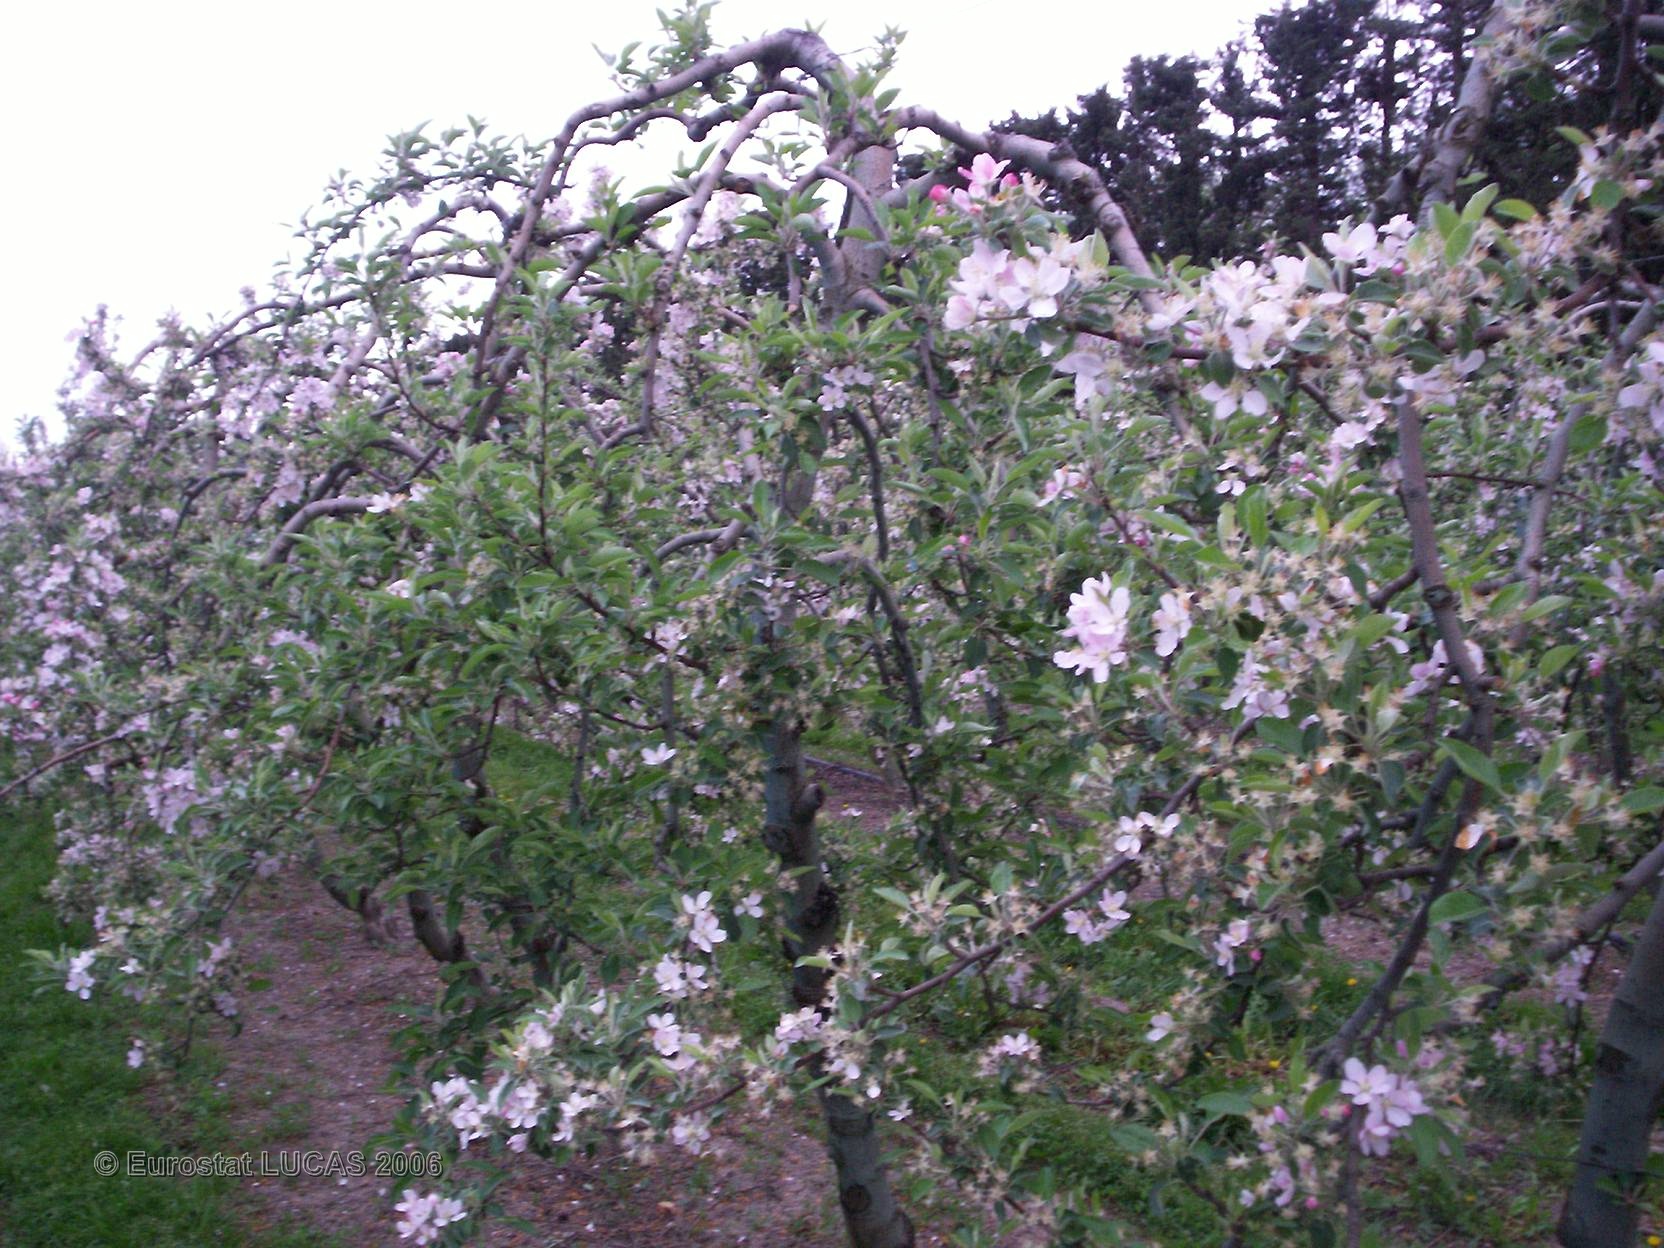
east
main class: Cropland
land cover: Apple fruit
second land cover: Grassland with sparse tree/shrub cover
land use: Agriculture (excluding fallow land and kitchen gardens)
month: April
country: FR
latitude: 43.8647
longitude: 4.9198
